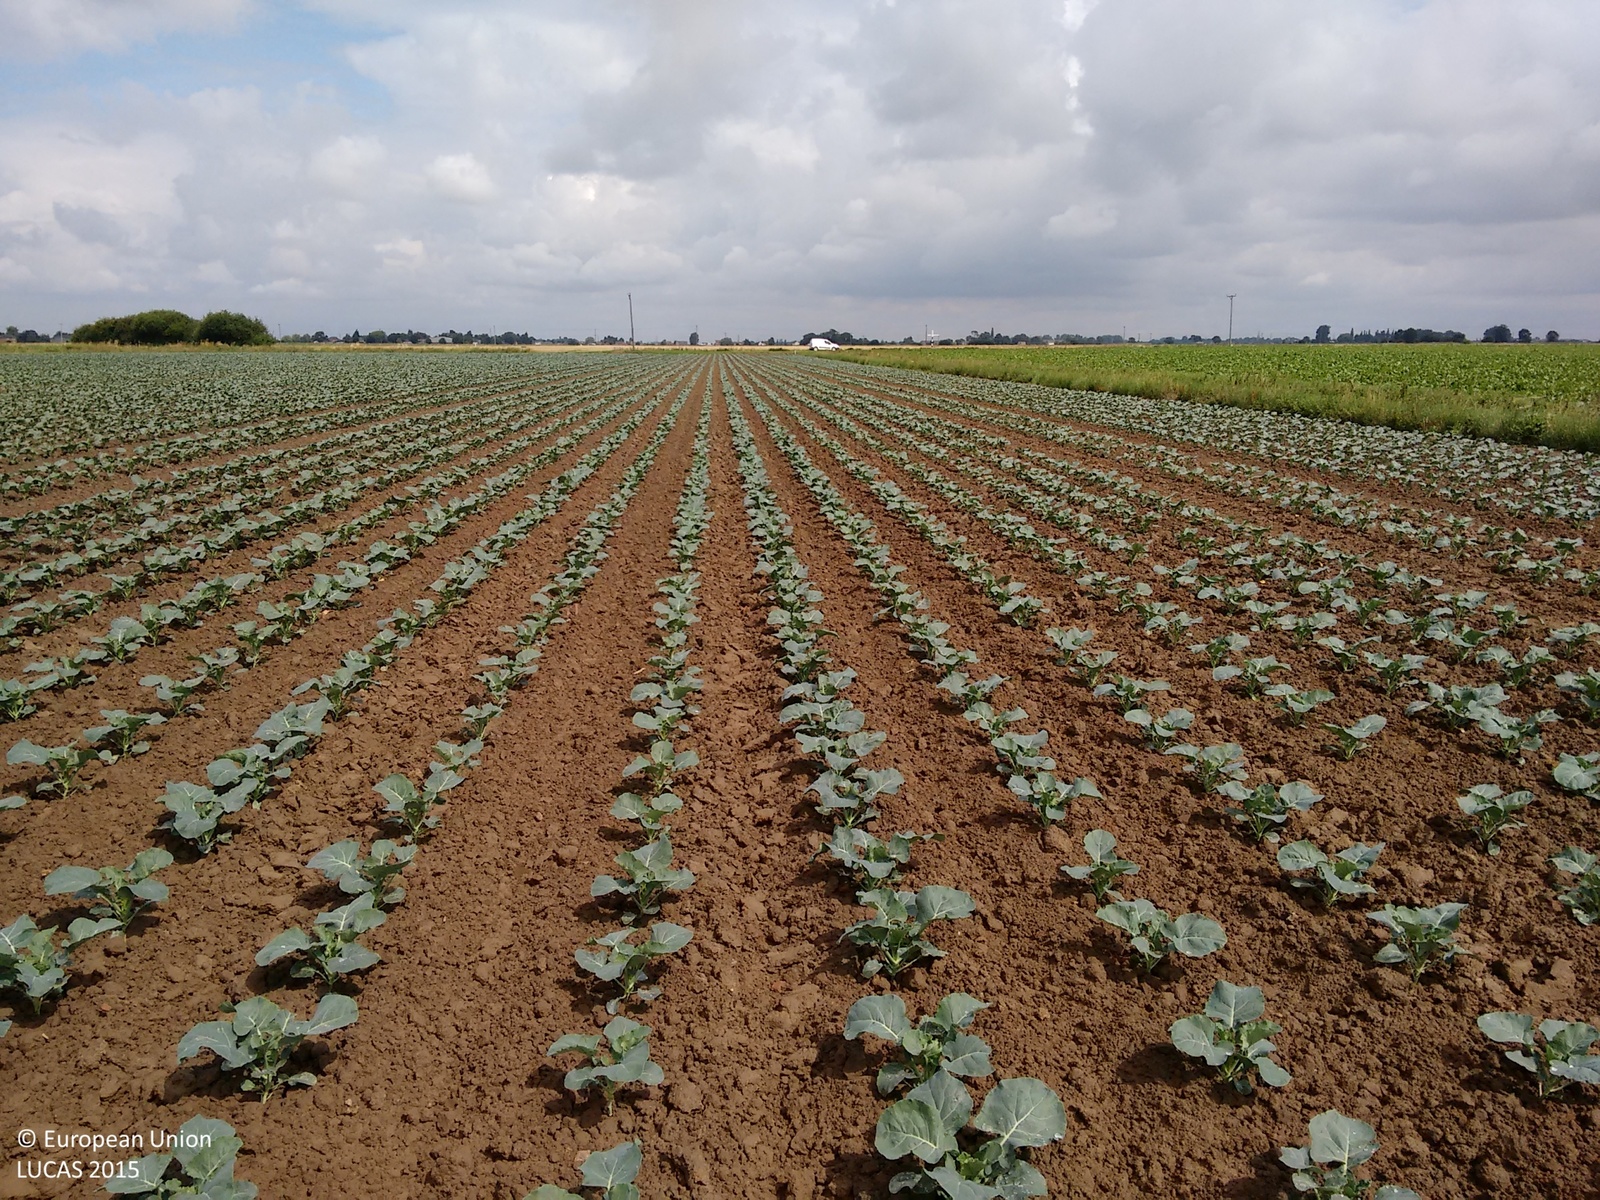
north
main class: Cropland
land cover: Other fresh vegetables
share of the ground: > 75 %
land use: Agriculture (excluding fallow land and kitchen gardens)
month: July
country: GB
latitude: 52.7615
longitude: -0.0955
